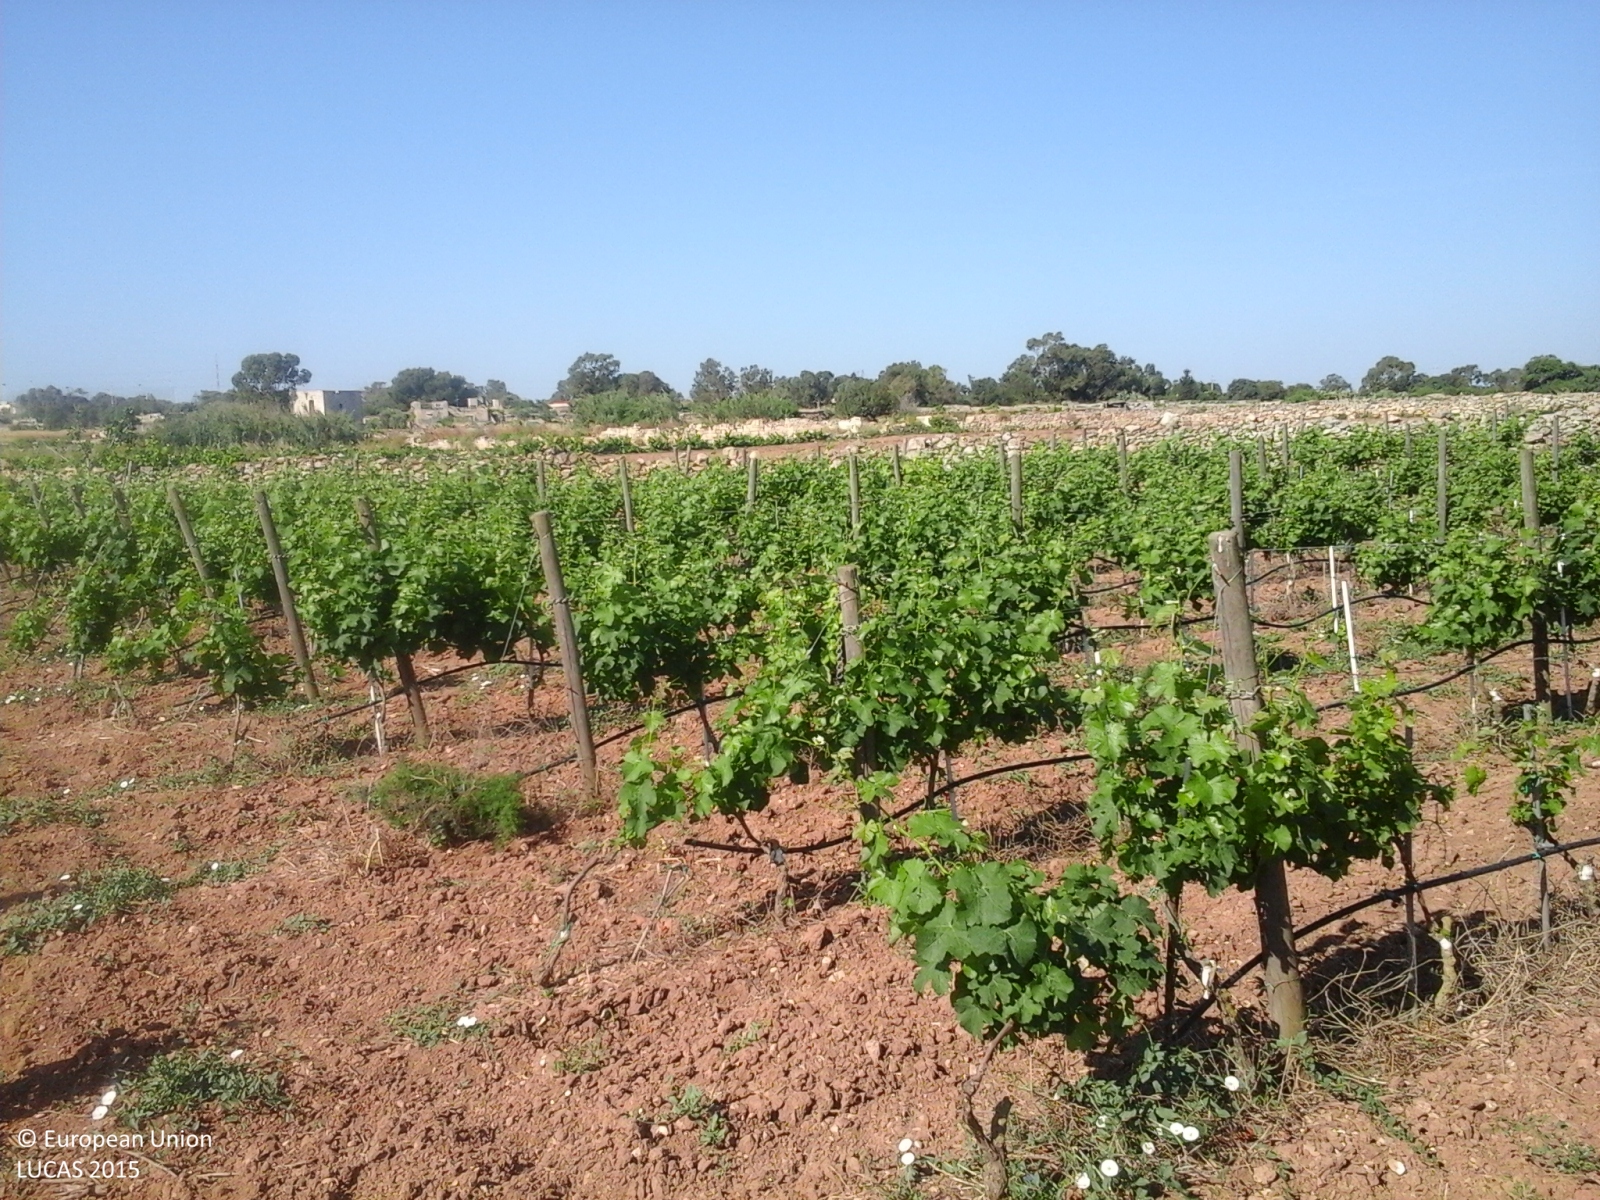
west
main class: Cropland
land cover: Vineyards
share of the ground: 25 - 50 %
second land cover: Other bare soil
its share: > 75 %
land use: Agriculture (excluding fallow land and kitchen gardens)
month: May
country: MT
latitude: 35.8571
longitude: 14.5094
